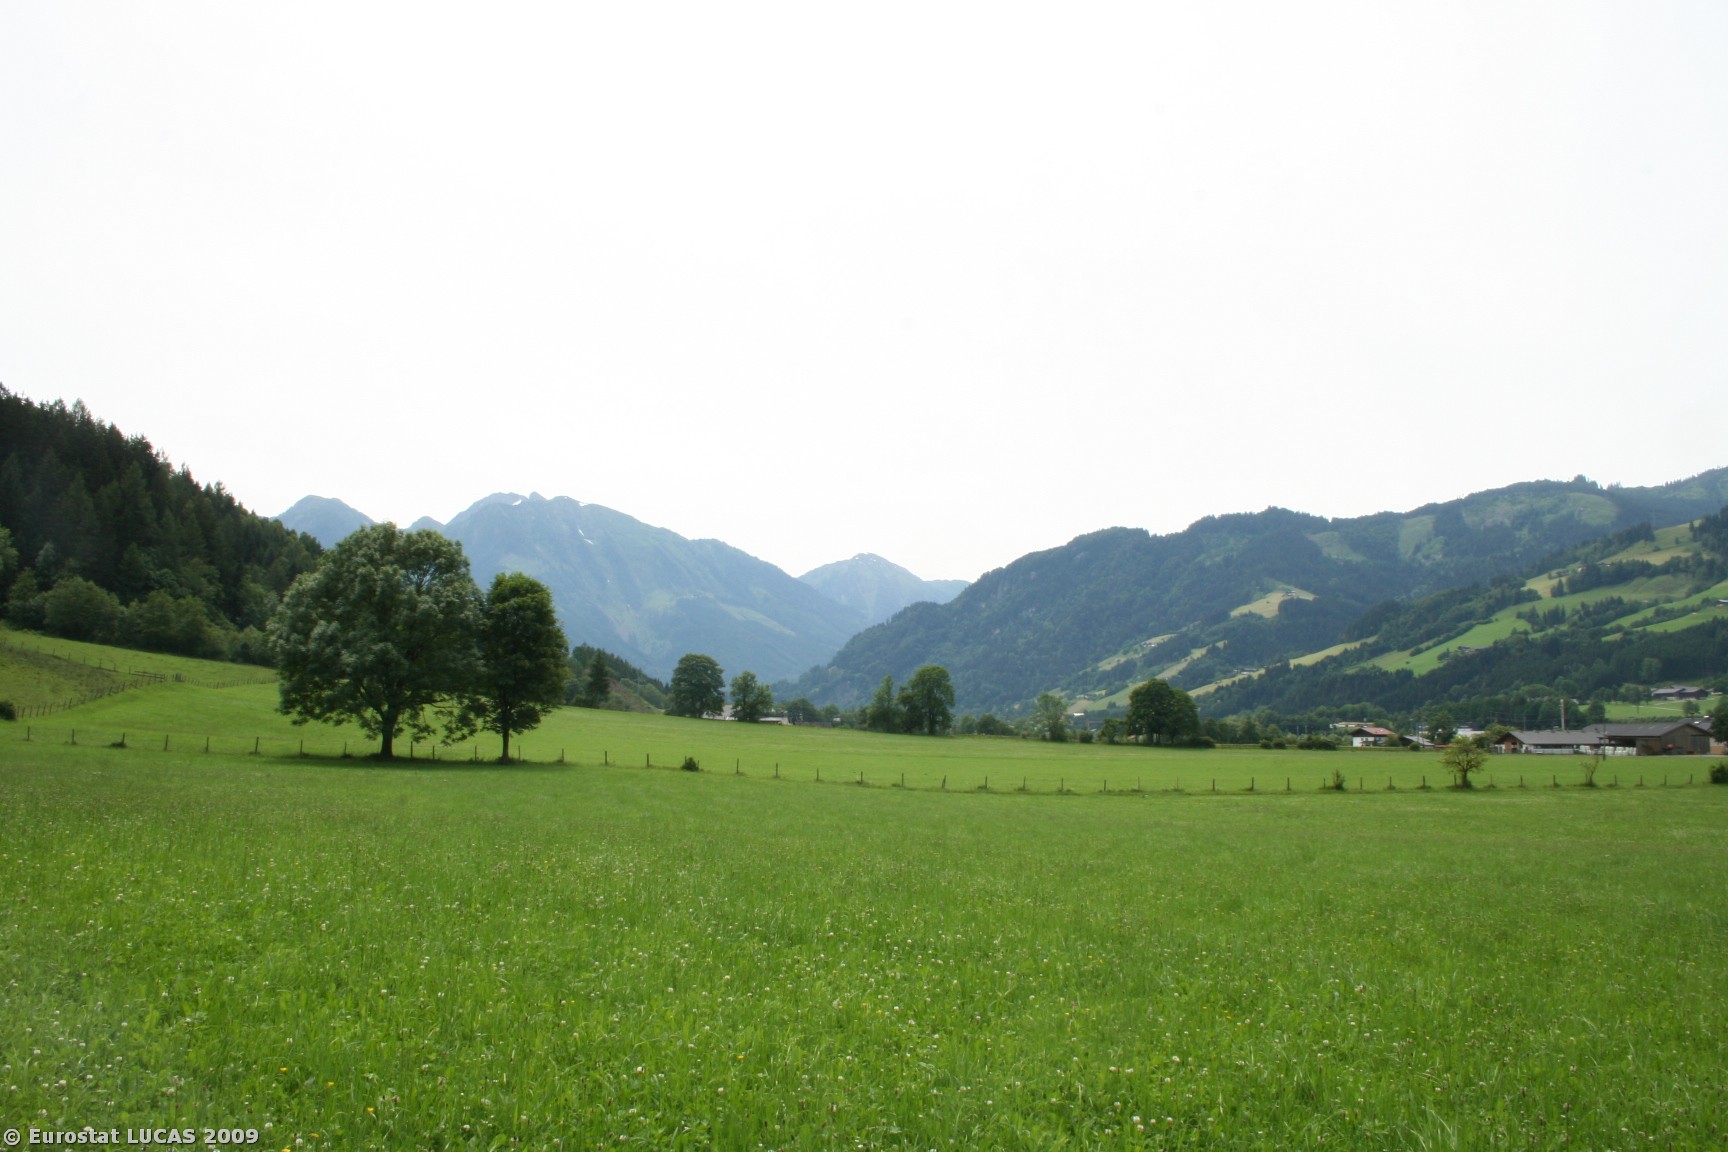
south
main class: Grassland
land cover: Grassland without tree/shrub cover
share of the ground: > 75 %
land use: Agriculture (excluding fallow land and kitchen gardens)
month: June
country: AT
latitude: 47.3661
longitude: 13.2159
